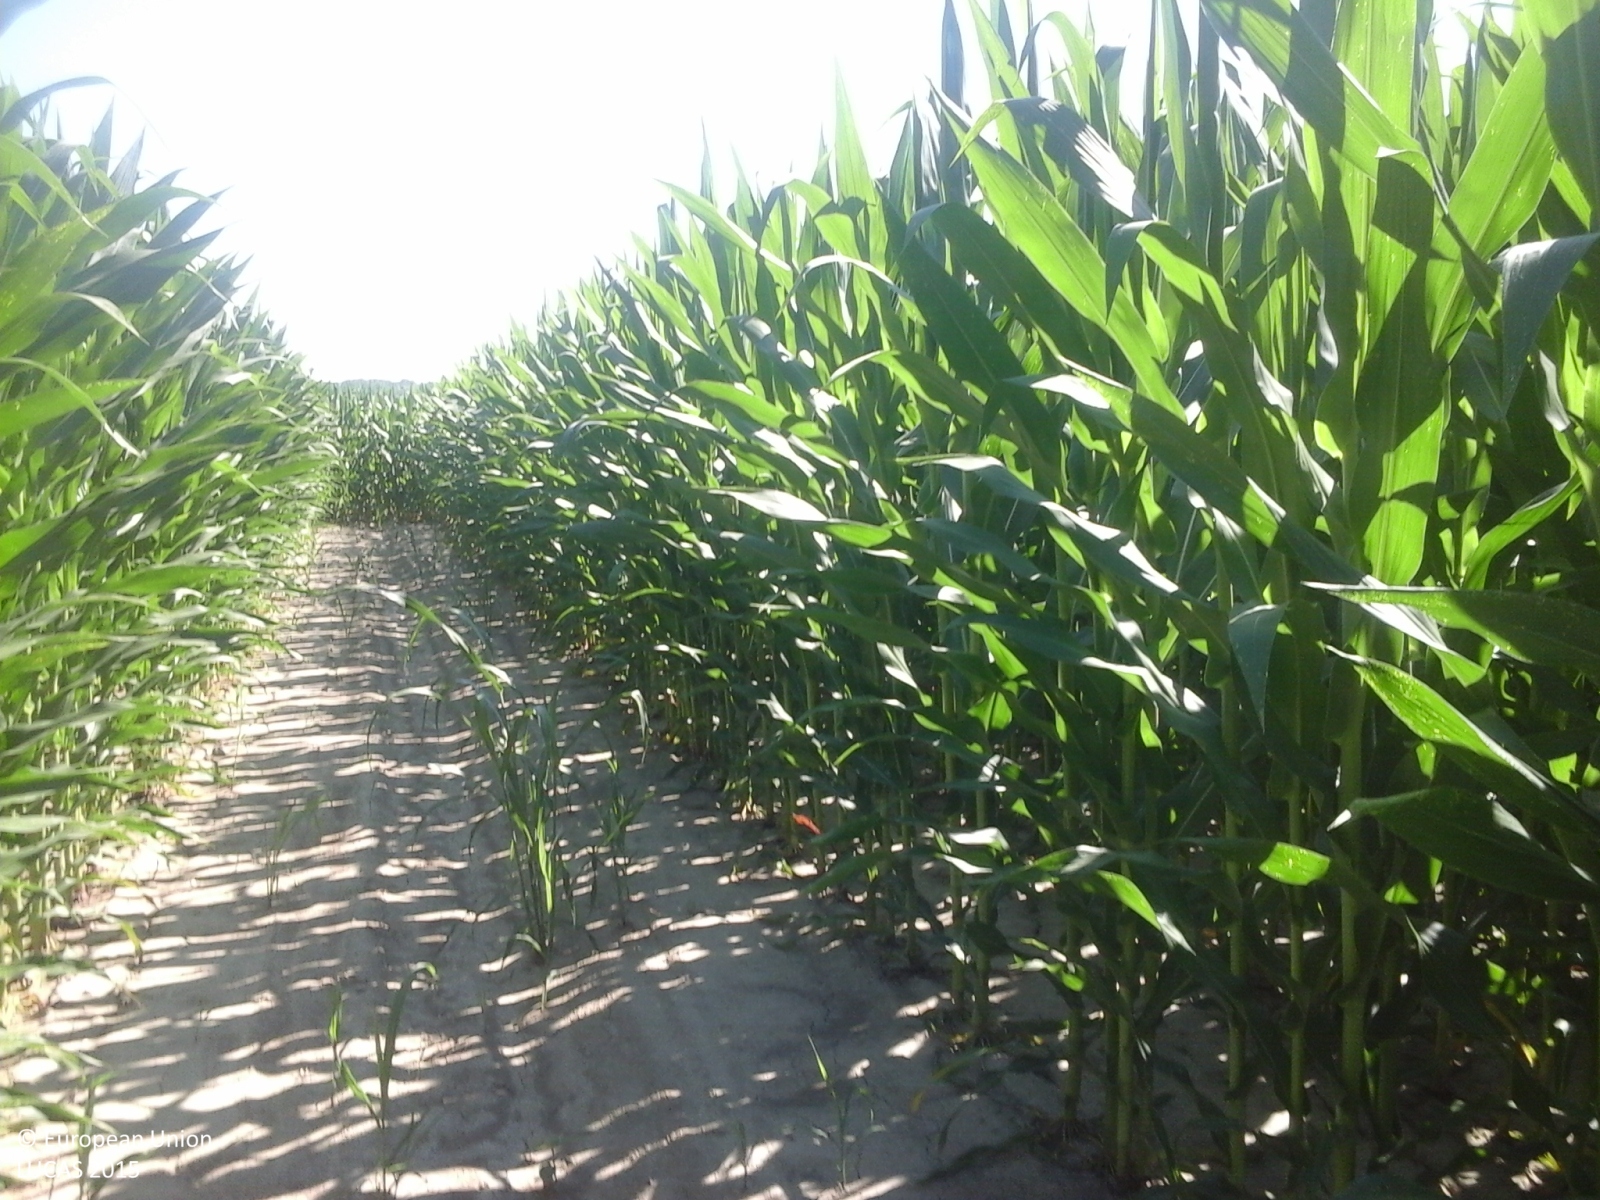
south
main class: Cropland
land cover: Maize
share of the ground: > 75 %
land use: Agriculture (excluding fallow land and kitchen gardens)
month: June
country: IT
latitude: 45.0804
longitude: 8.5925
